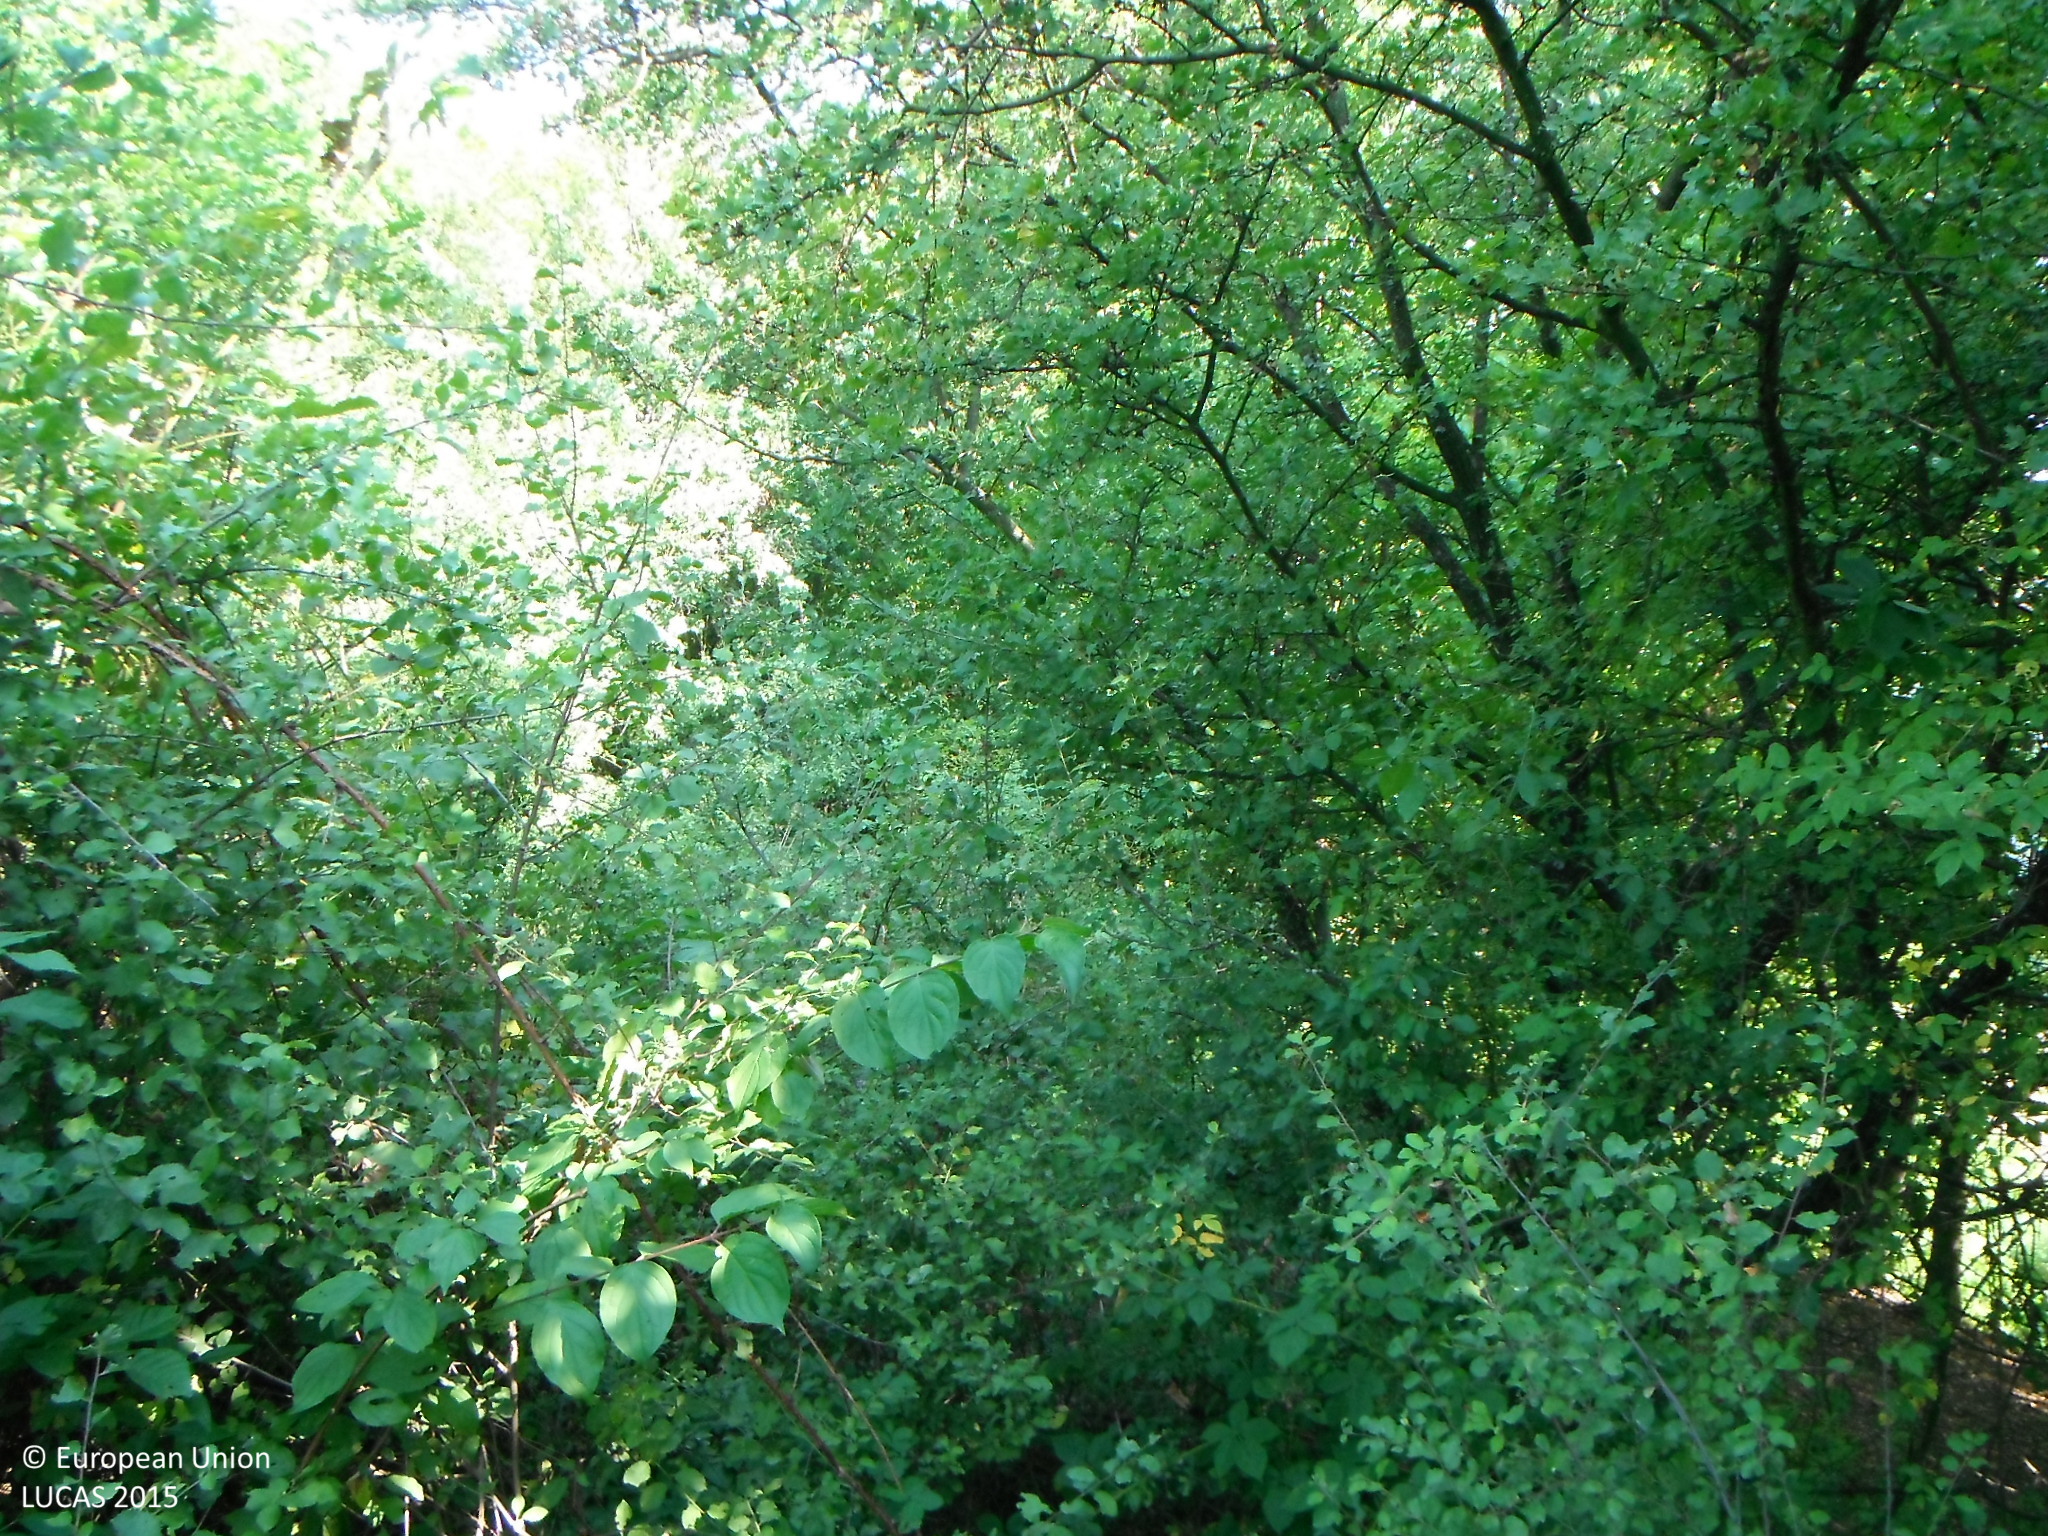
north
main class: Woodland
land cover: Broadleaved woodland
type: mesophytic deciduous forest
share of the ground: > 75 %
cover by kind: broadleaved forest trees 100 %
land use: Forestry
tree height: > 5 m
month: August
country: SK
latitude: 48.3220
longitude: 19.2606
